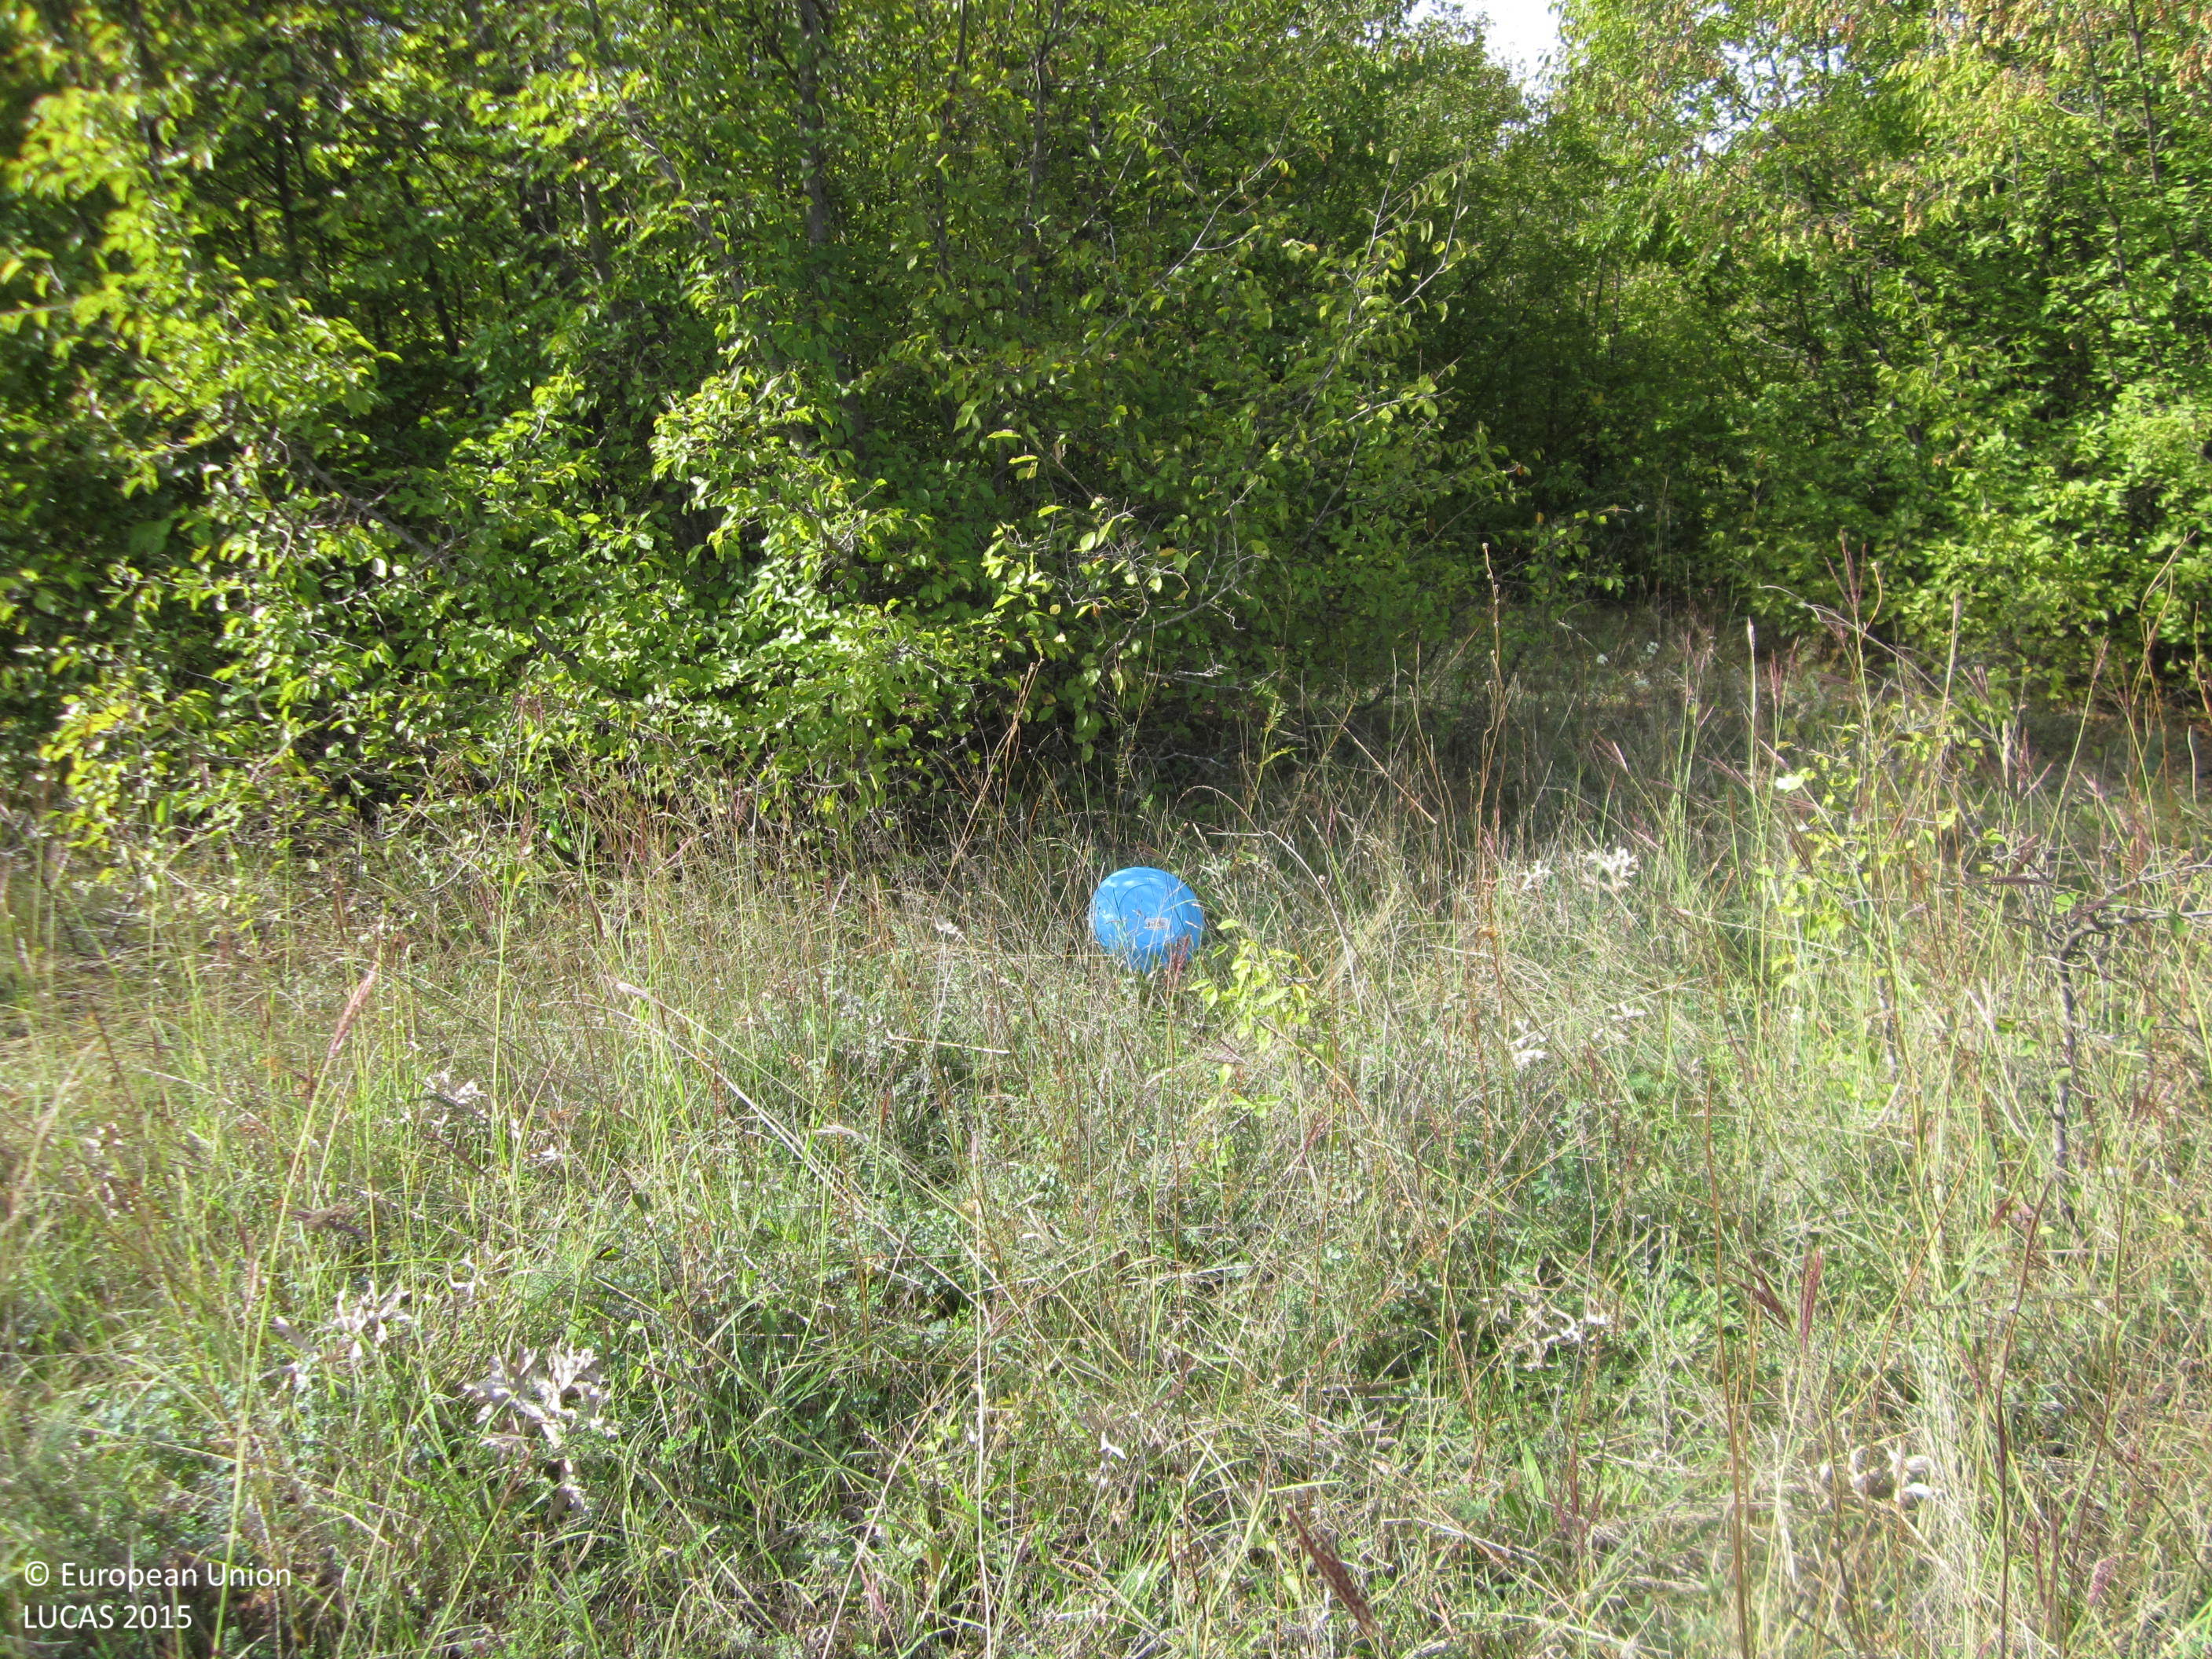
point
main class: Shrubland
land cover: Shrubland with sparse tree cover
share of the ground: 25 - 50 %
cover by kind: herbaceous plants 55 %, shrubs 40 %, broadleaved forest trees 5 %
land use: Semi-natural and natural areas not in use
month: October
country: BG
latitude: 42.8919
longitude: 26.8200
